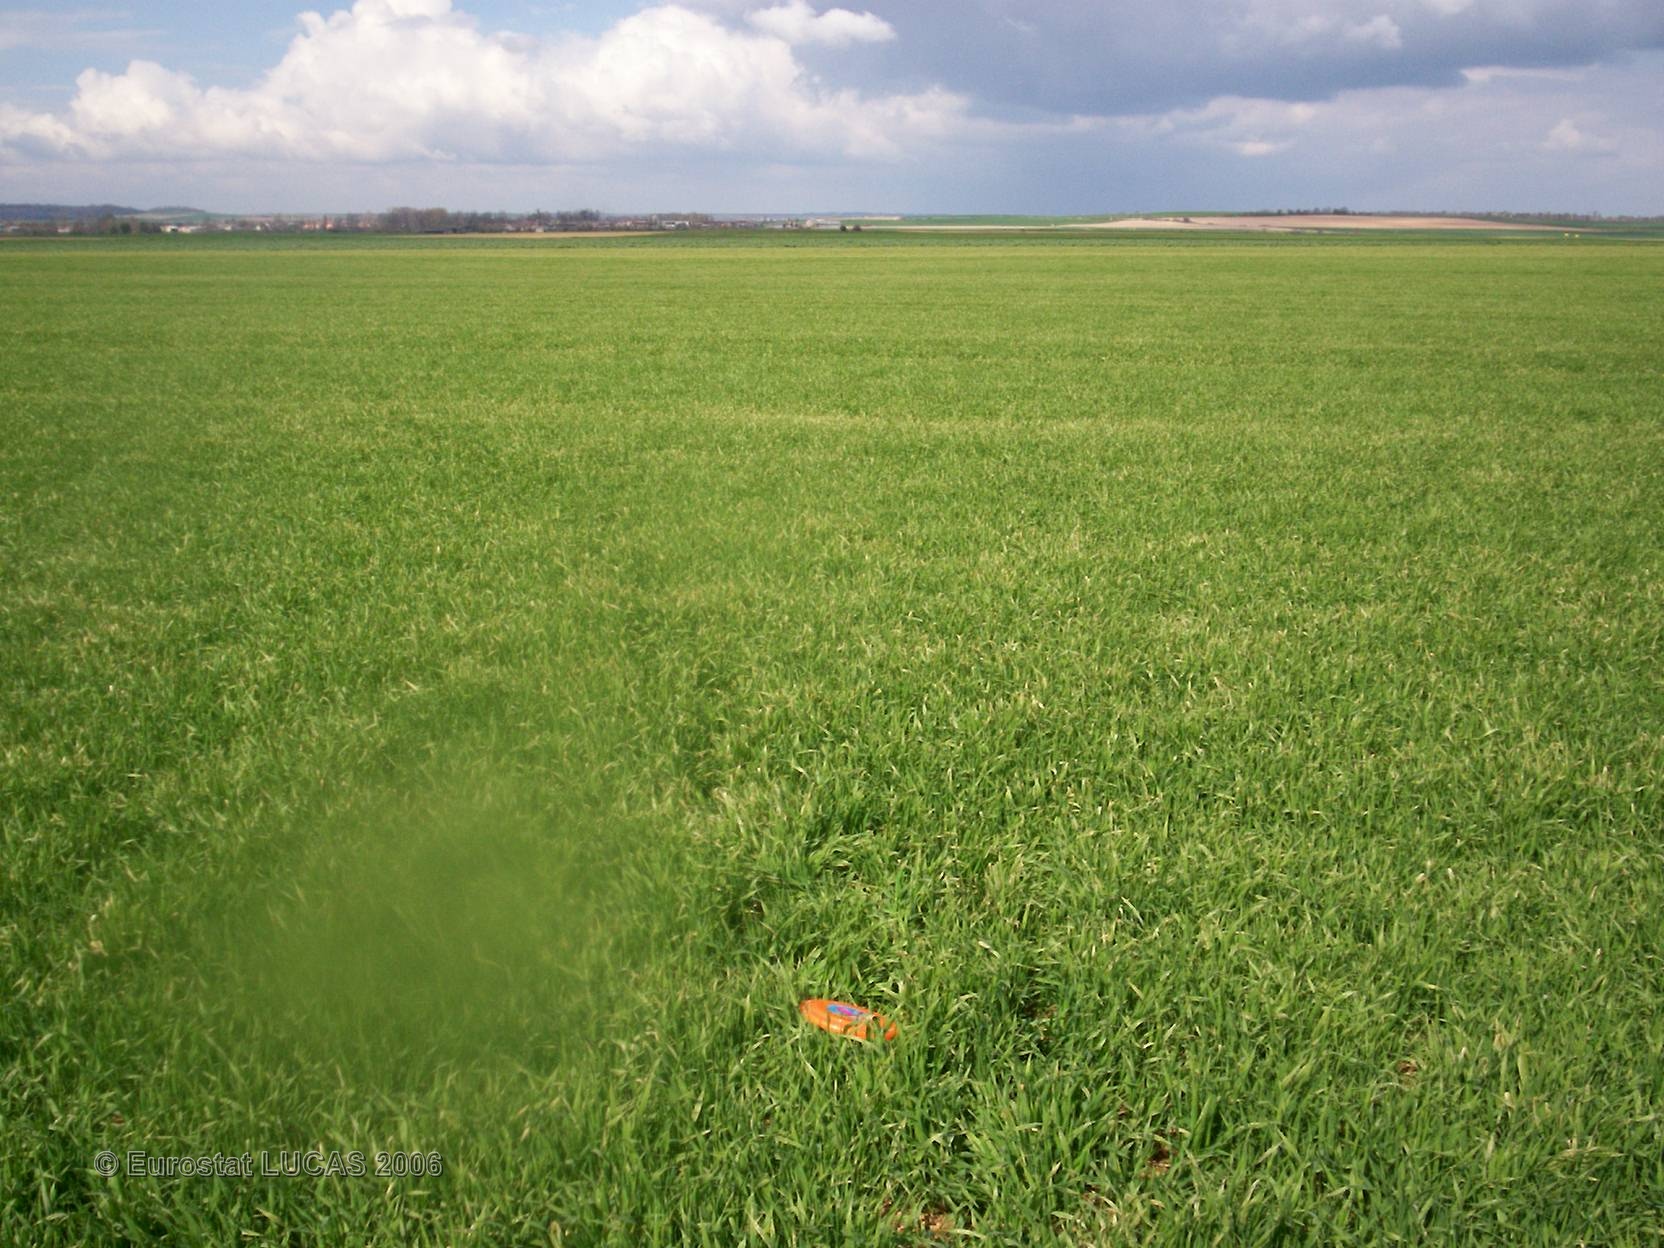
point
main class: Cropland
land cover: Common wheat
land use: Agriculture (excluding fallow land and kitchen gardens)
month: April
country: FR
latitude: 48.9045
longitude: -0.0585
